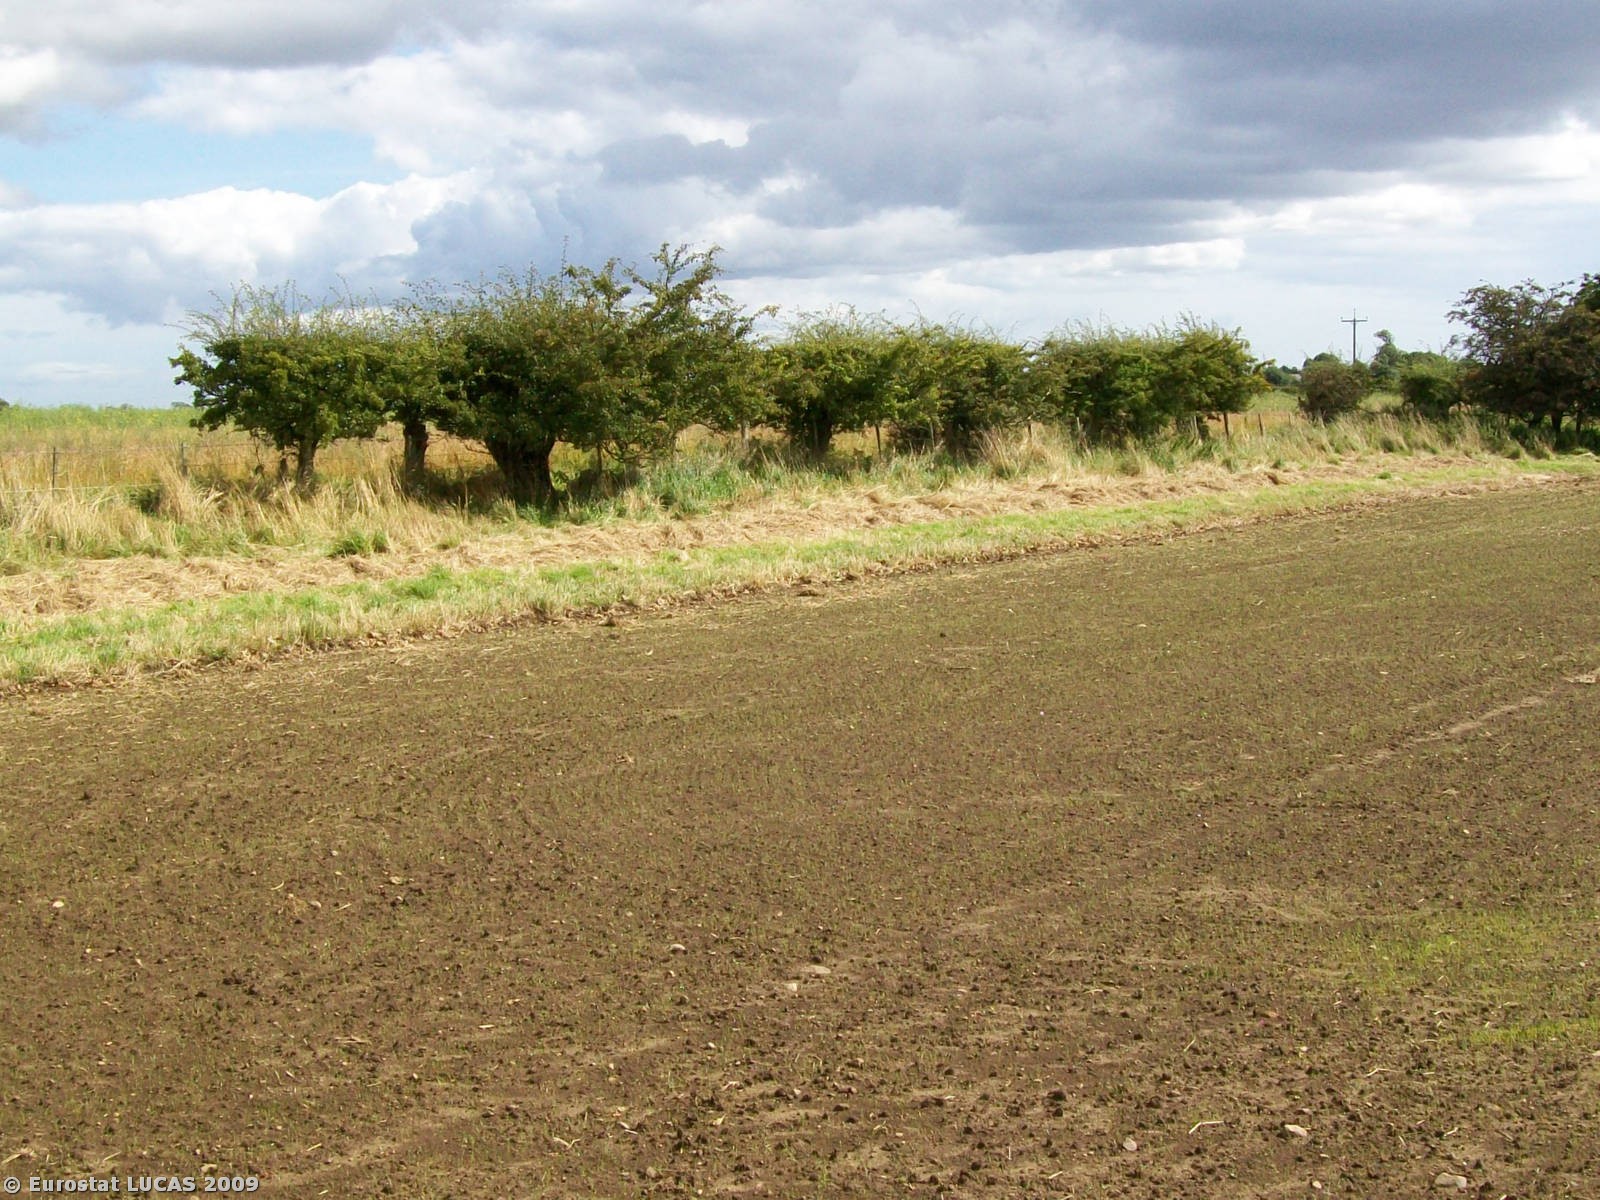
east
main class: Grassland
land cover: Grassland without tree/shrub cover
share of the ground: 10 - 25 %
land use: Agriculture (excluding fallow land and kitchen gardens)
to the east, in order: Grassland without tree/shrub cover; Temporary grasslands; Fences; Managed hedges; Temporary grasslands; Rape and turnip rape
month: September
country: GB
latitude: 55.1702
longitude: -1.7784
